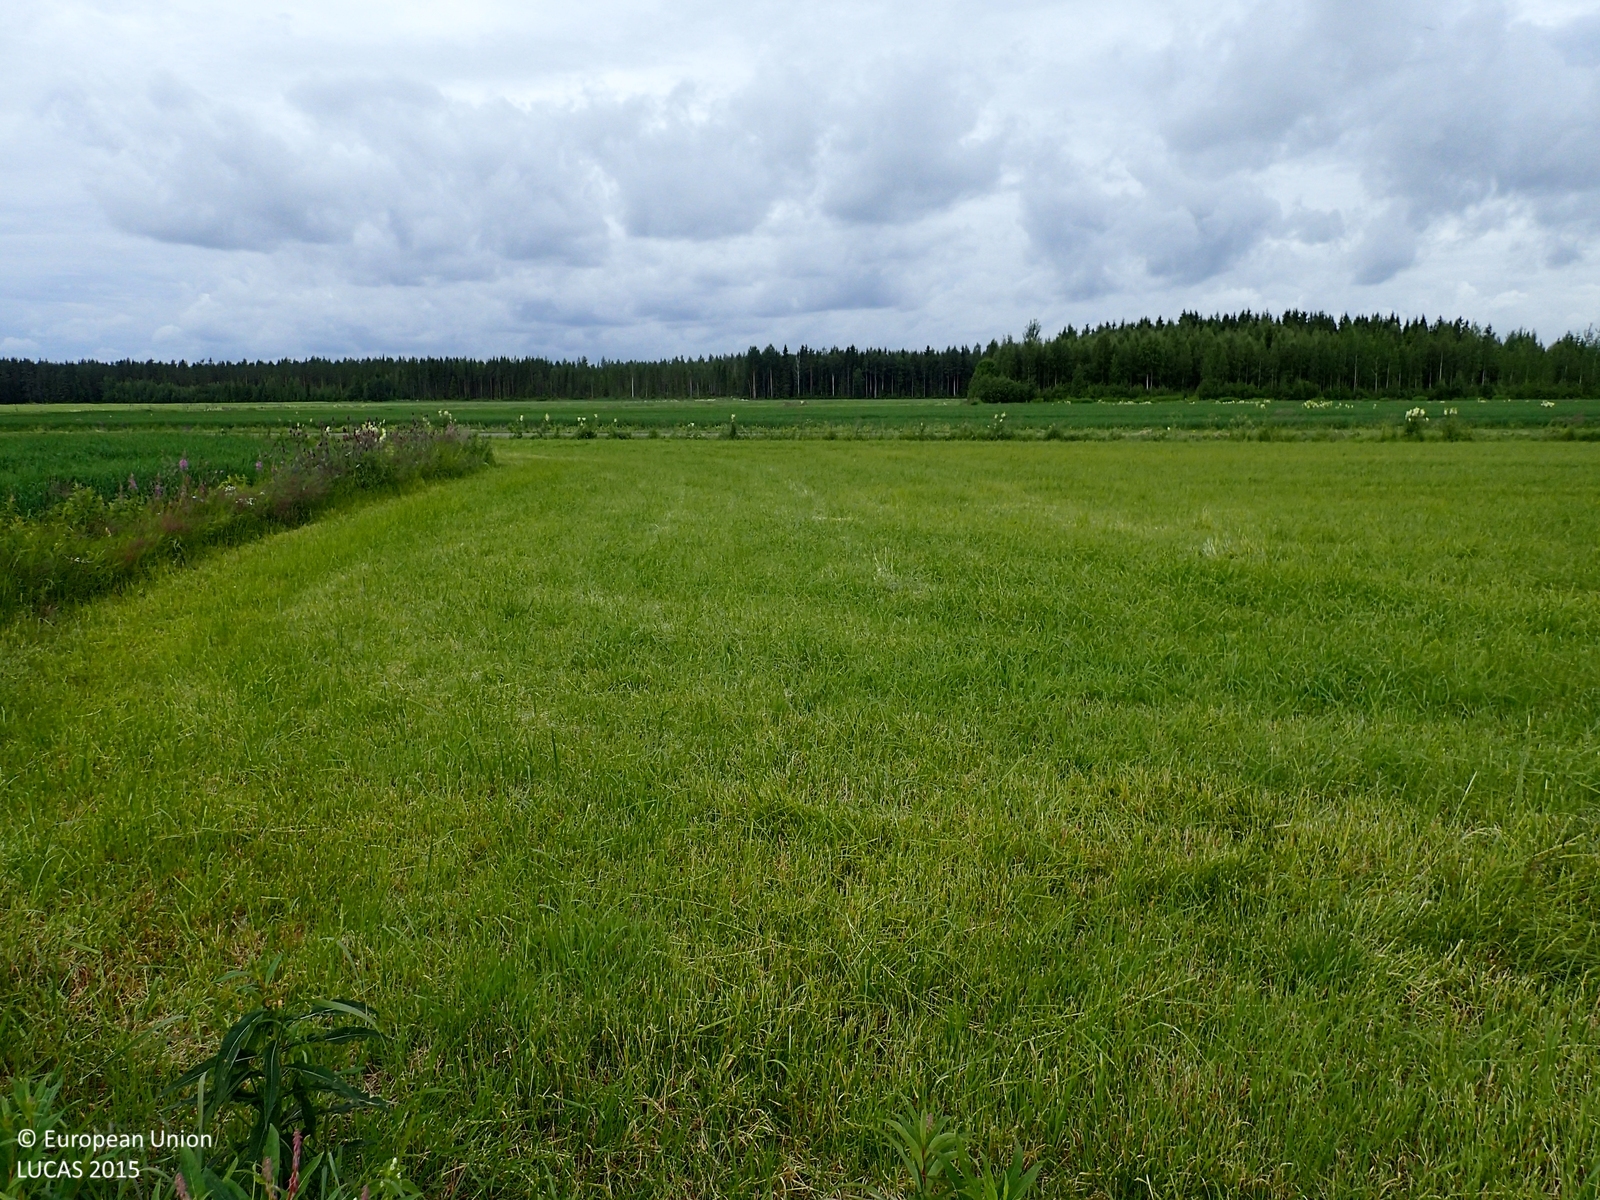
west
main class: Cropland
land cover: Oats
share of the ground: > 75 %
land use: Agriculture (excluding fallow land and kitchen gardens)
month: July
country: FI
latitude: 62.9163
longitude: 23.3139
